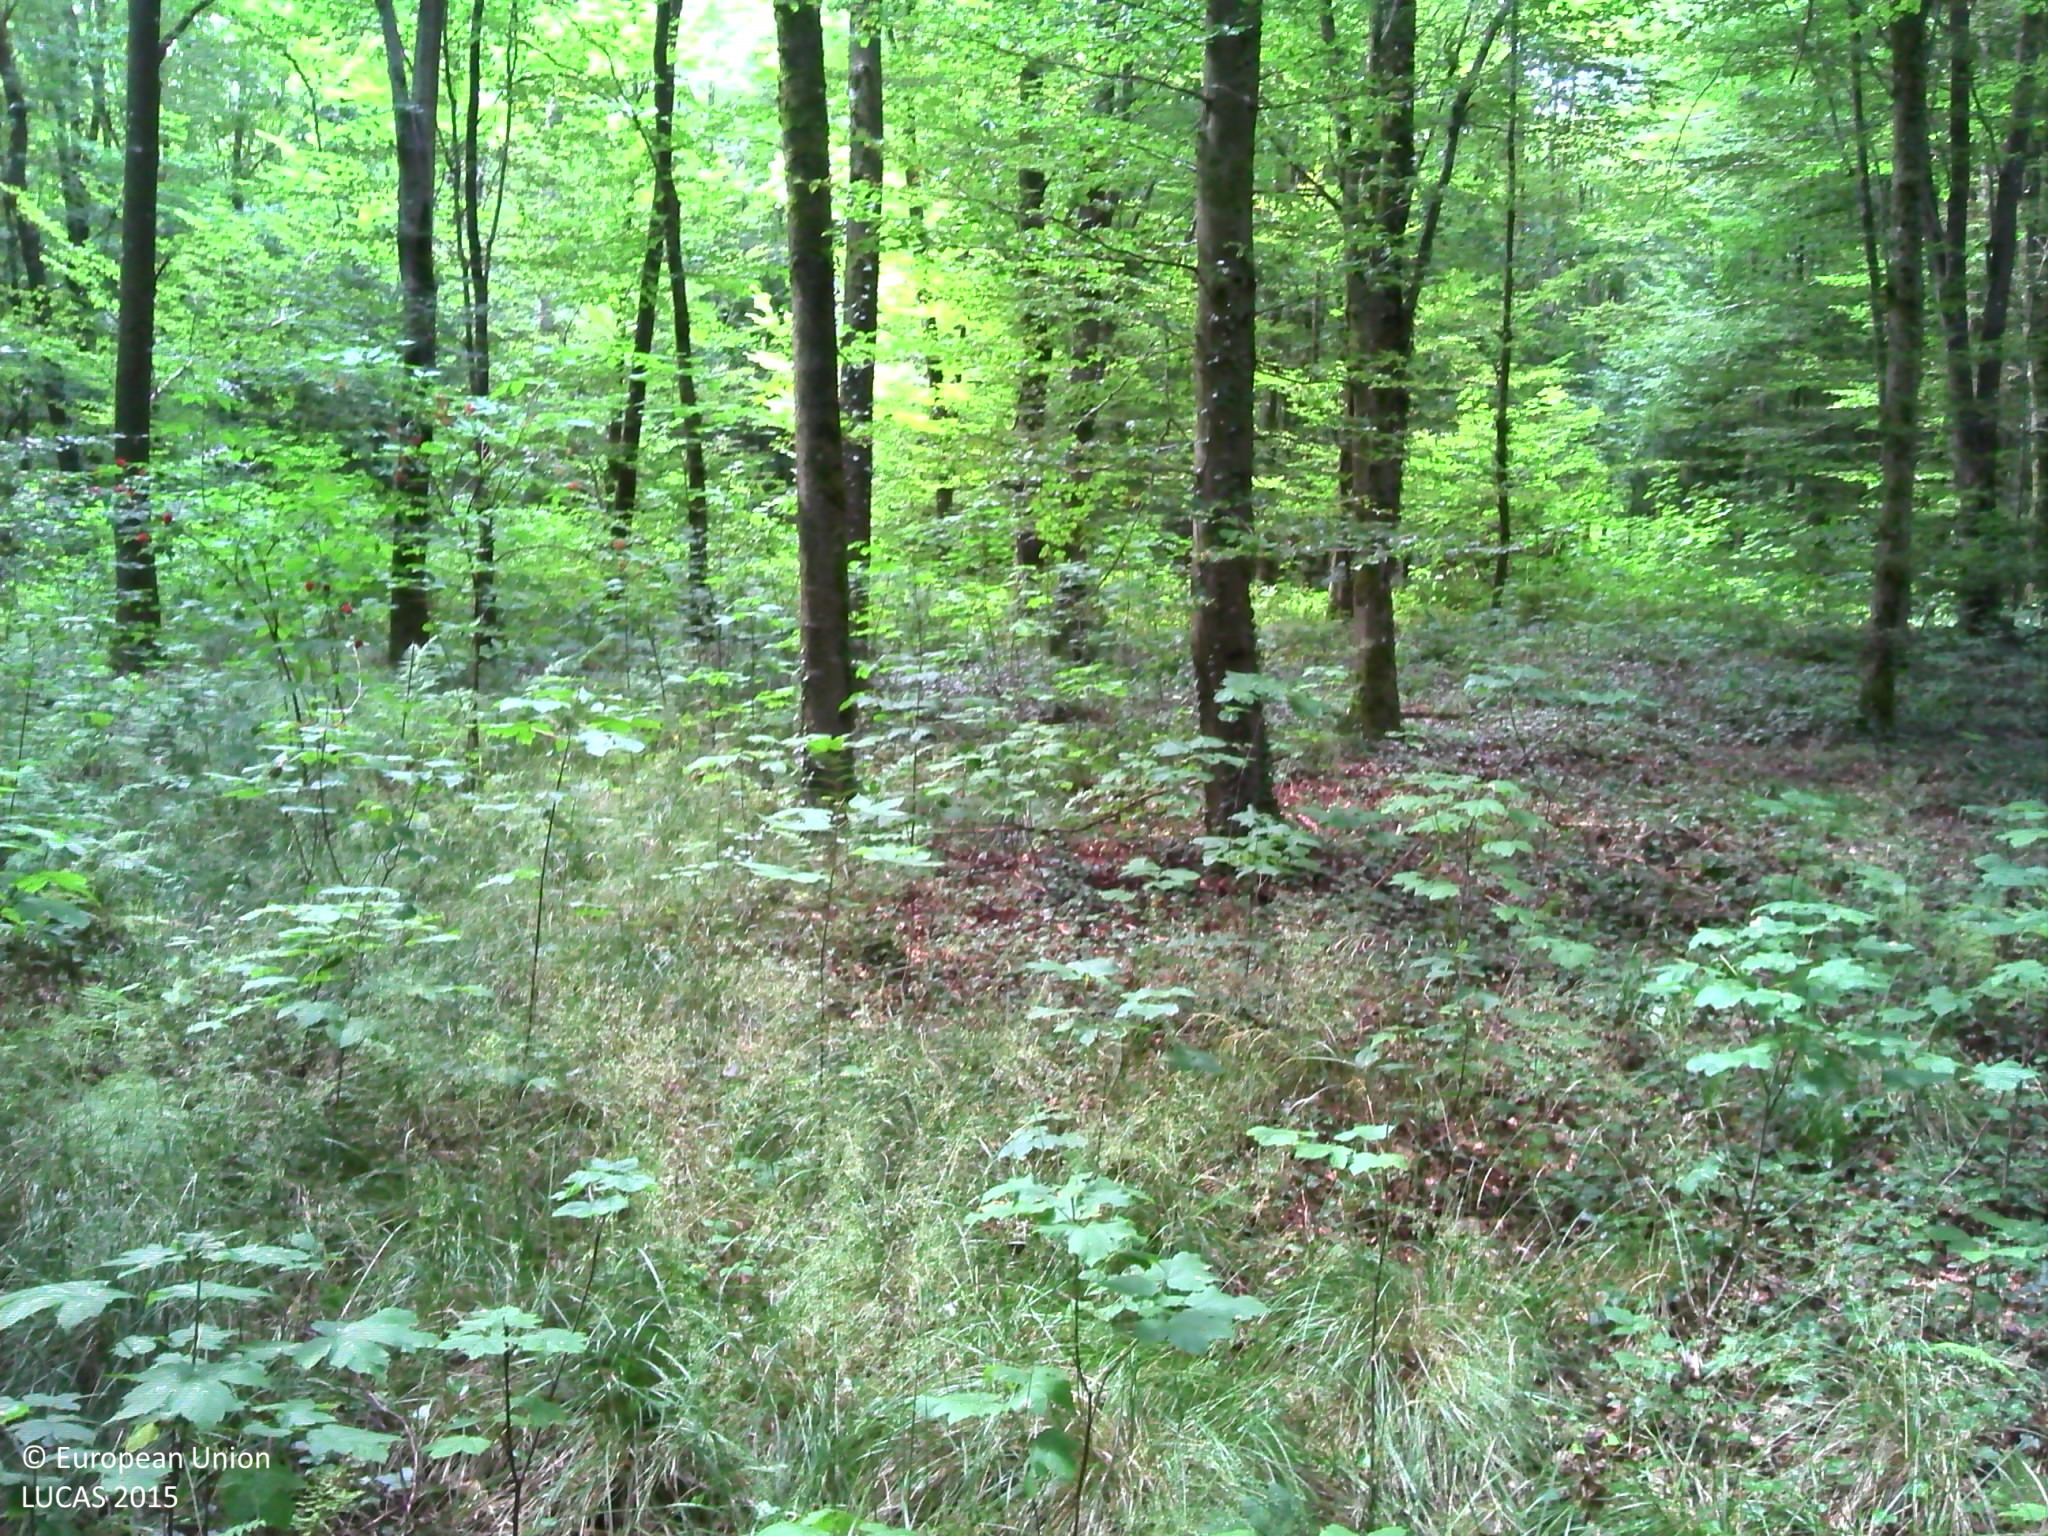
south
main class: Woodland
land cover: Broadleaved woodland
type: beech forest
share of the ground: > 75 %
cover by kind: broadleaved forest trees 95 %, herbaceous plants 5 %
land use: Forestry
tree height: > 5 m
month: July
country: BE
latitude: 49.6125
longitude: 5.5837
